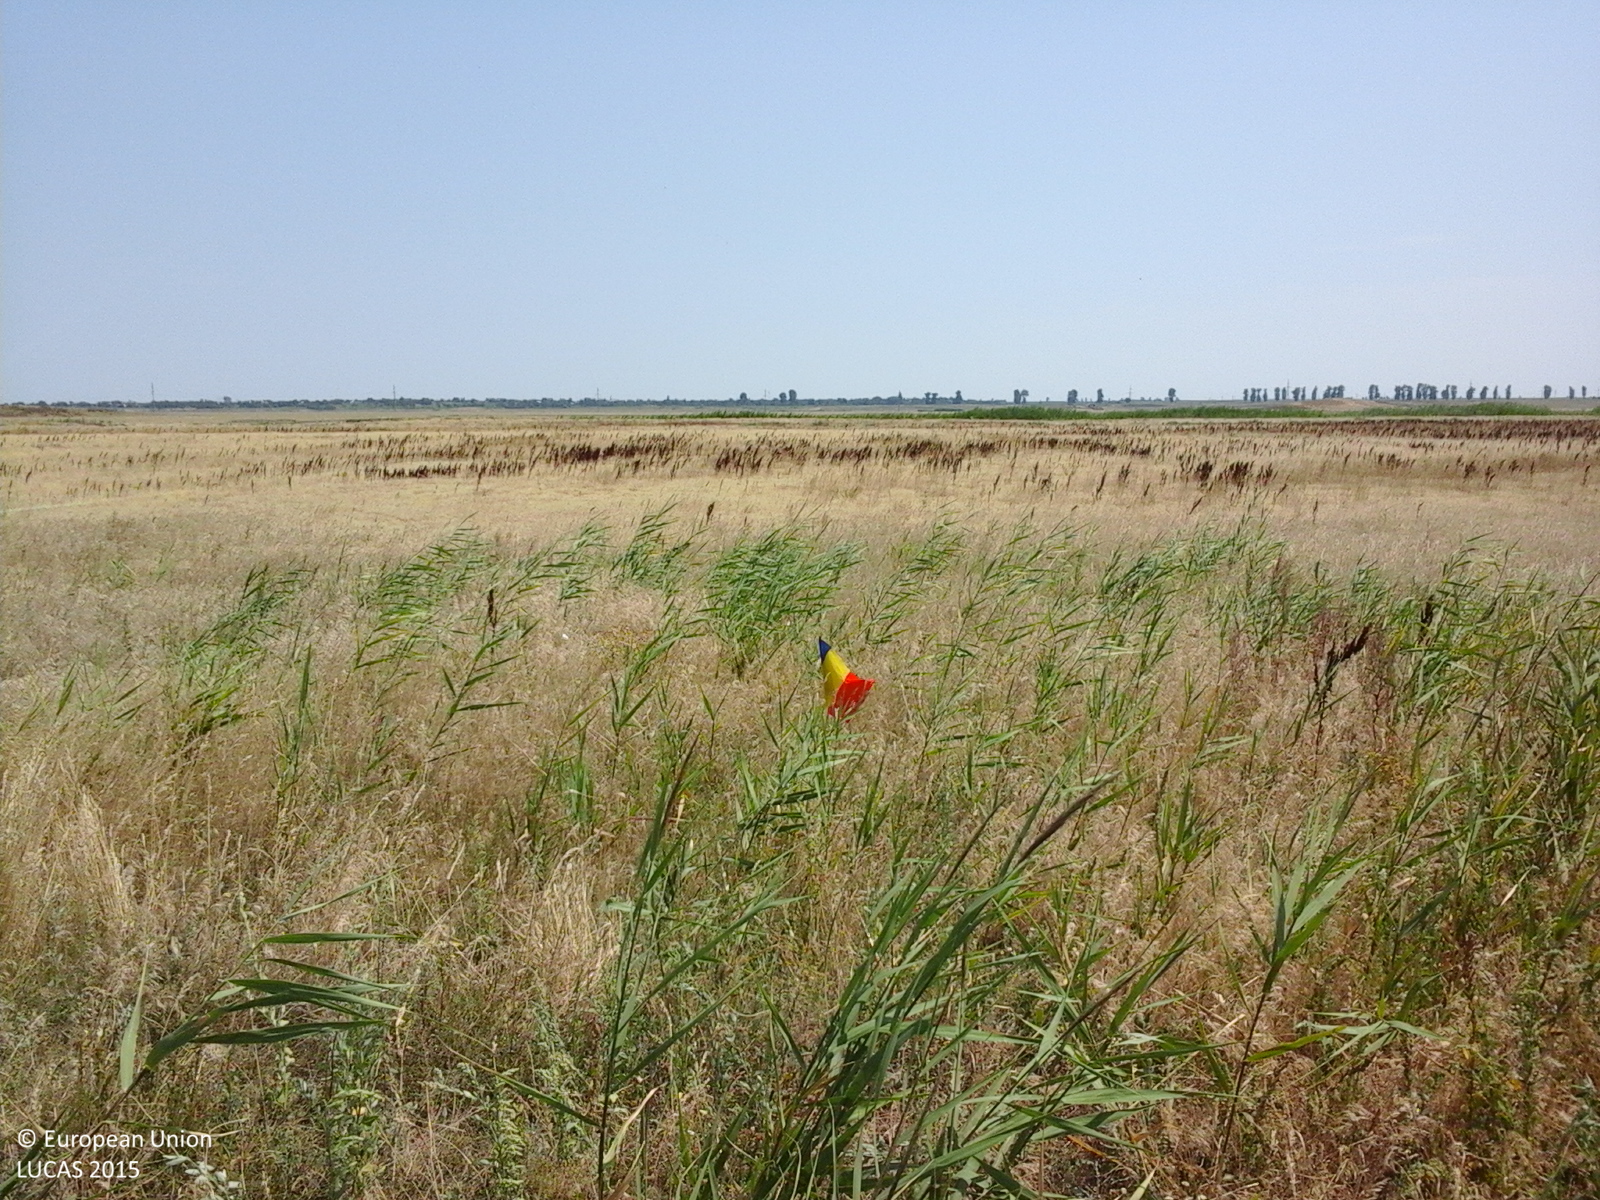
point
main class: Grassland
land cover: Spontaneously vegetated surfaces
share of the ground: > 75 %
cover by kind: herbaceous plants 100 %
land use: Fallow land
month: July
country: RO
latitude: 44.9693
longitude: 27.2709
